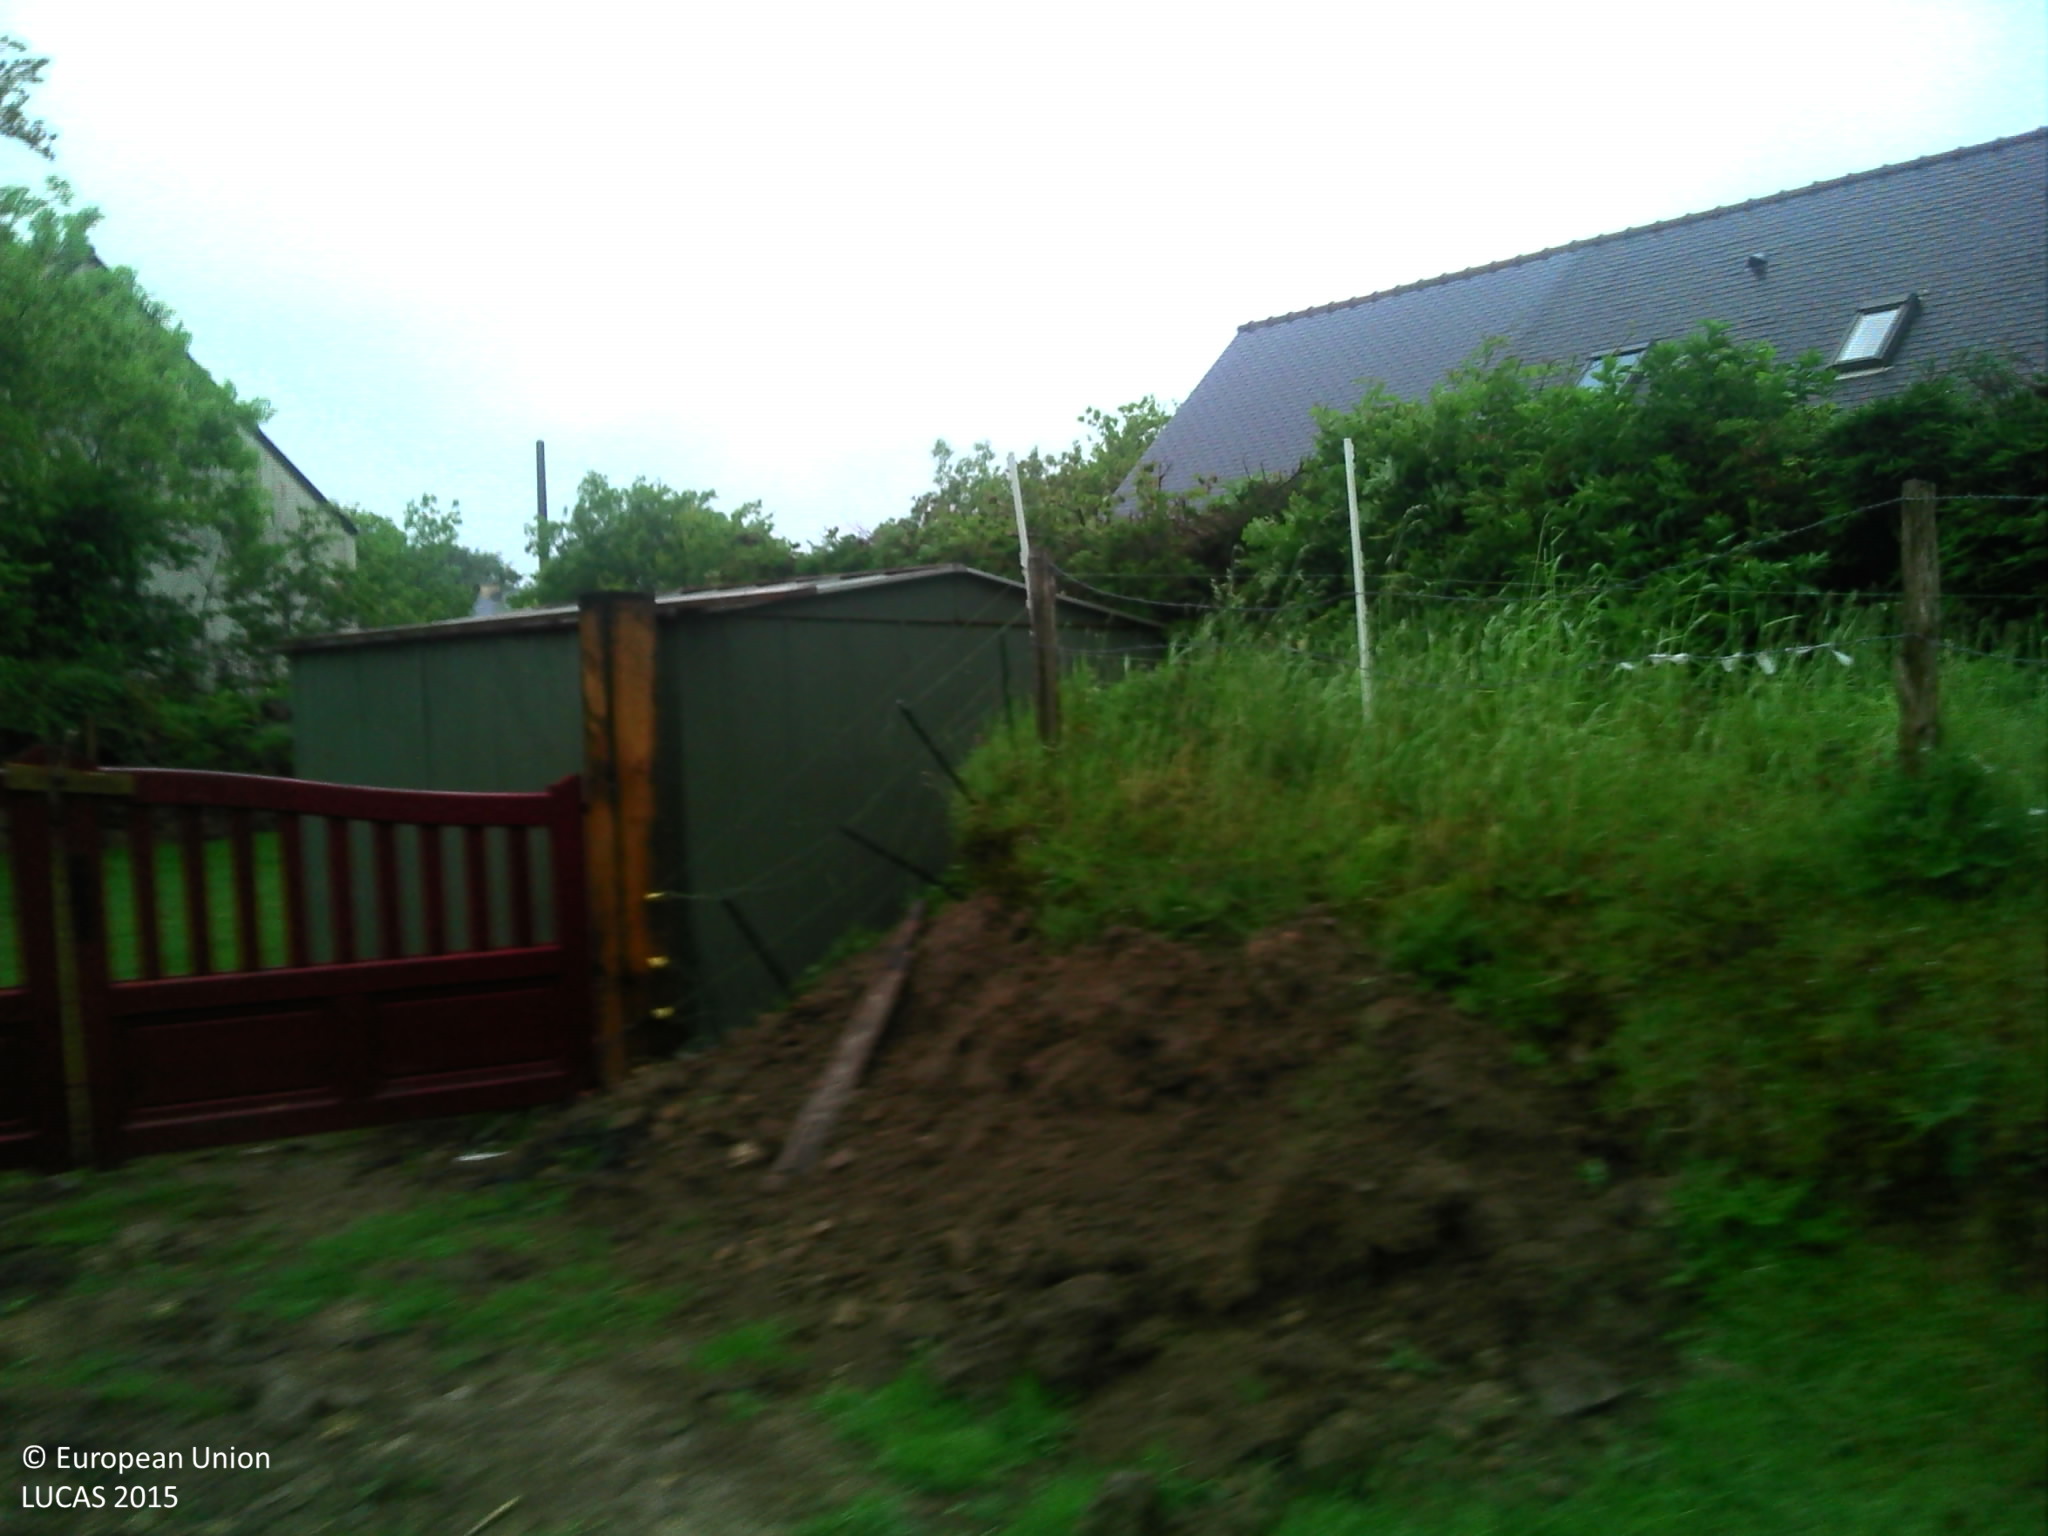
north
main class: Grassland
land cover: Grassland without tree/shrub cover
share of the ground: > 75 %
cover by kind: herbaceous plants 95 %, shrubs 5 %
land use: Agriculture (excluding fallow land and kitchen gardens)
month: June
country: FR
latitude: 49.6228
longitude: -1.8065
